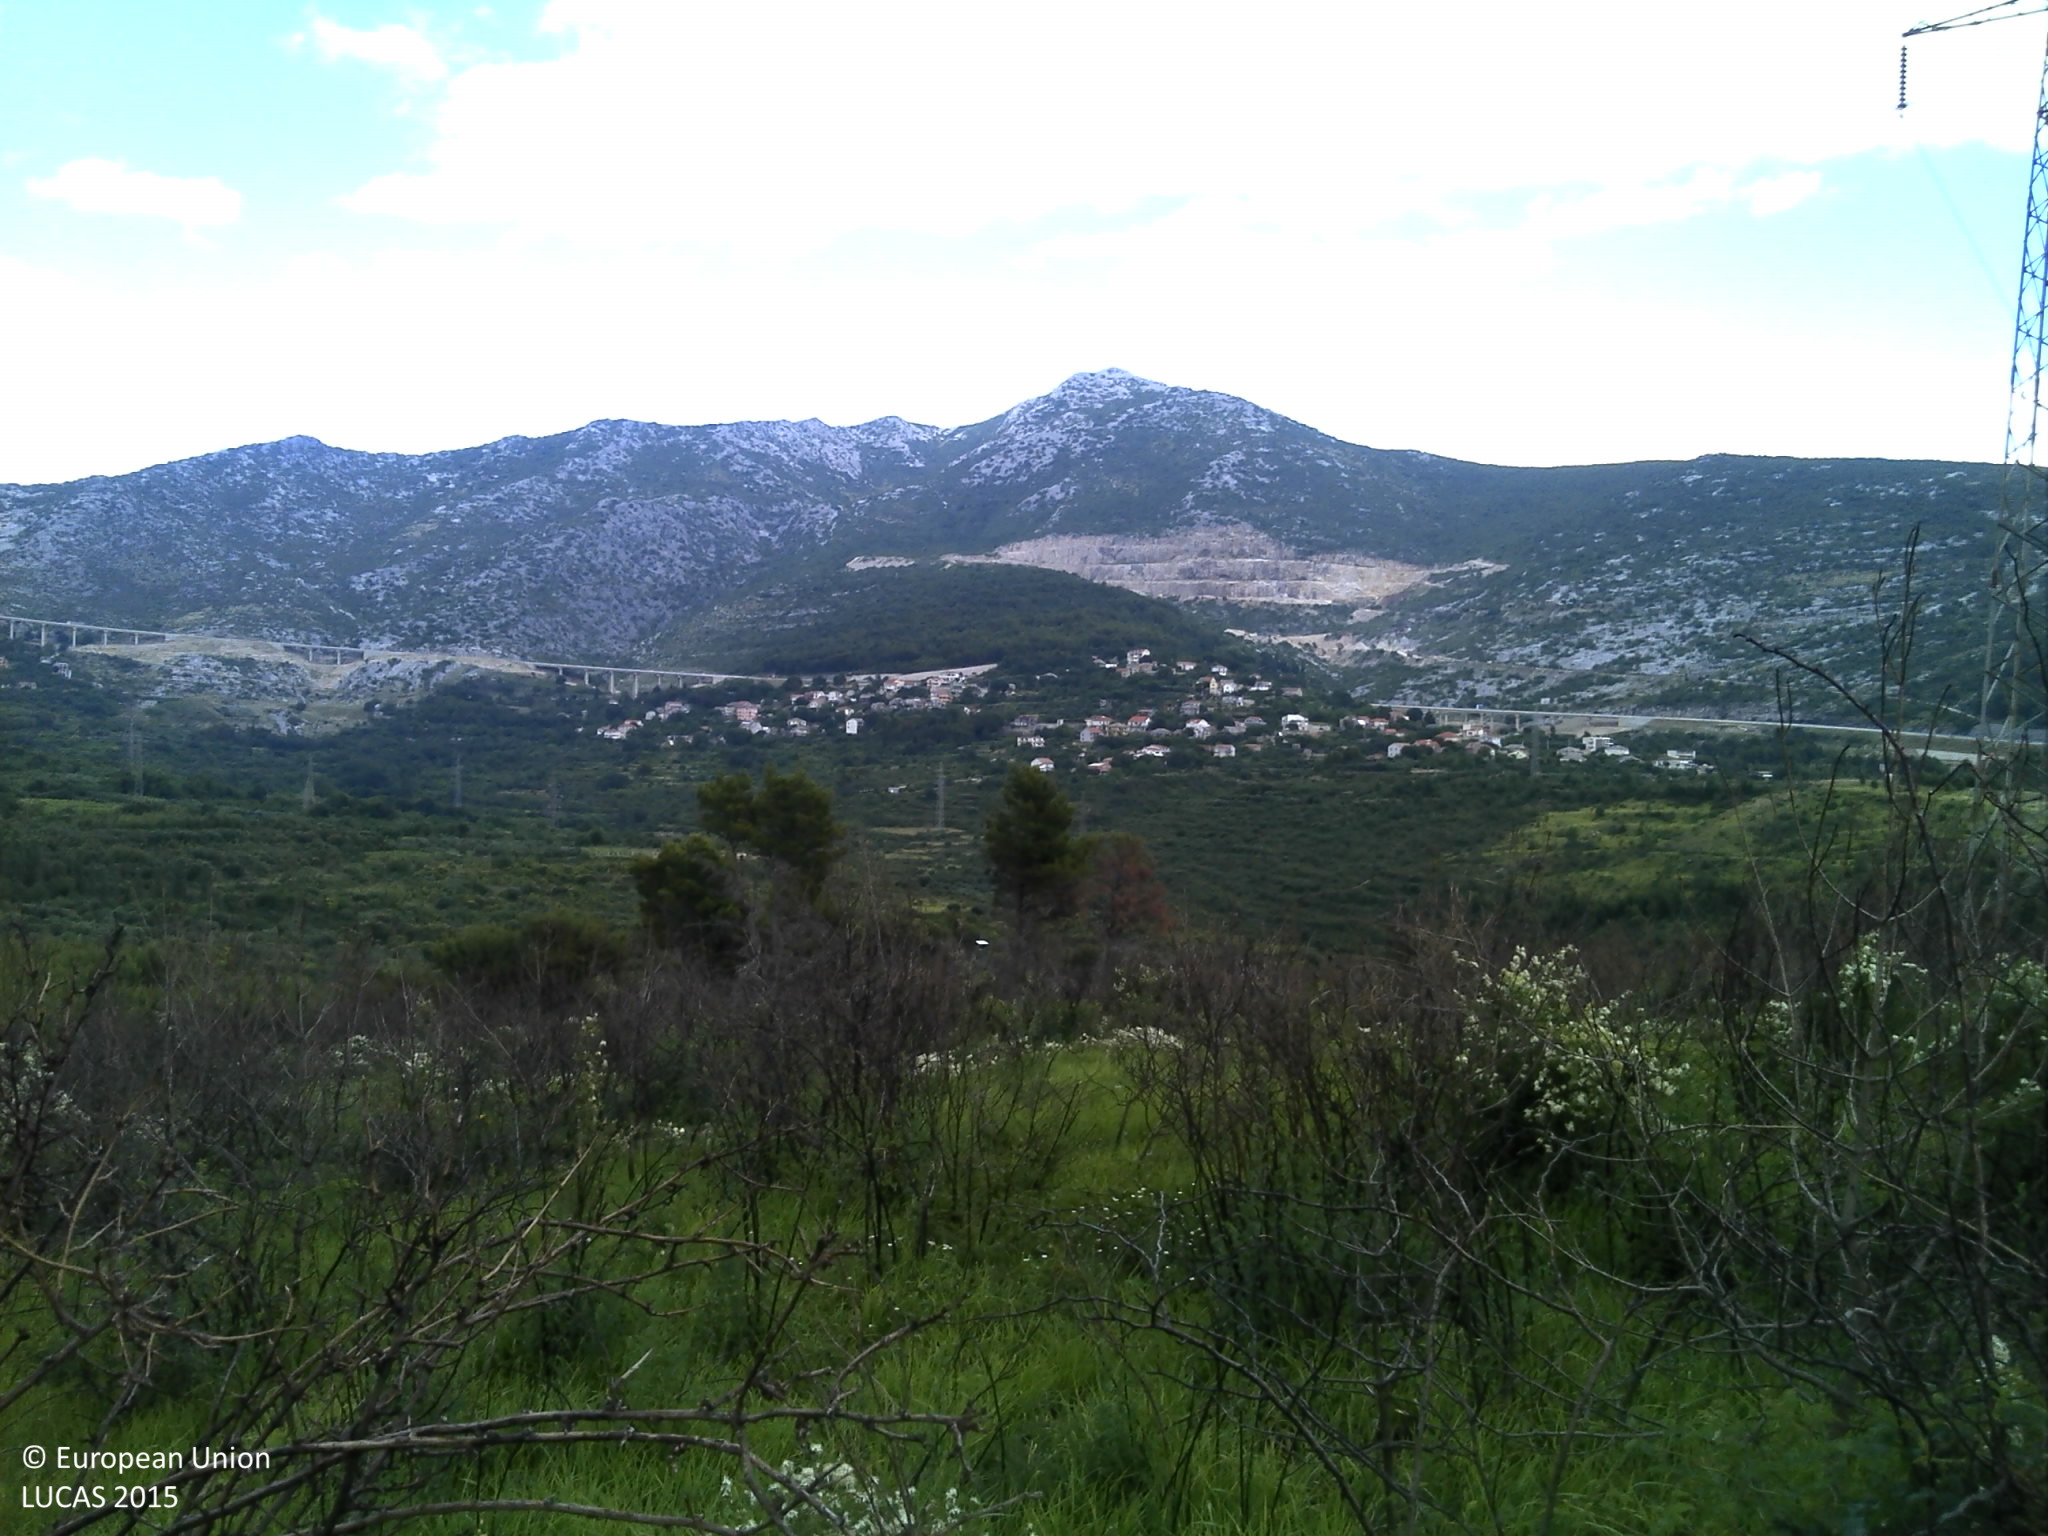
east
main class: Grassland
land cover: Spontaneously vegetated surfaces
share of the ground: > 75 %
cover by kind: herbaceous plants 80 %, shrubs 5 %, lichens and mosses 5 %, consolidated bare surface 5 %, unconsolidated bare surface 5 %
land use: Semi-natural and natural areas not in use
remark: Burnt area
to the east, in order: Spontaneously vegetated surfaces; Shrubland with sparse tree cover; Electric lines; Shrubland with sparse tree cover; Dry stone walls; Olive groves; Dry stone walls; Olive groves; Dry stone walls; Tracks; Ditches and canals; Other mixed woodland; Shrubland with sparse tree cover
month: June
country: HR
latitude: 43.5487
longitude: 16.5140
